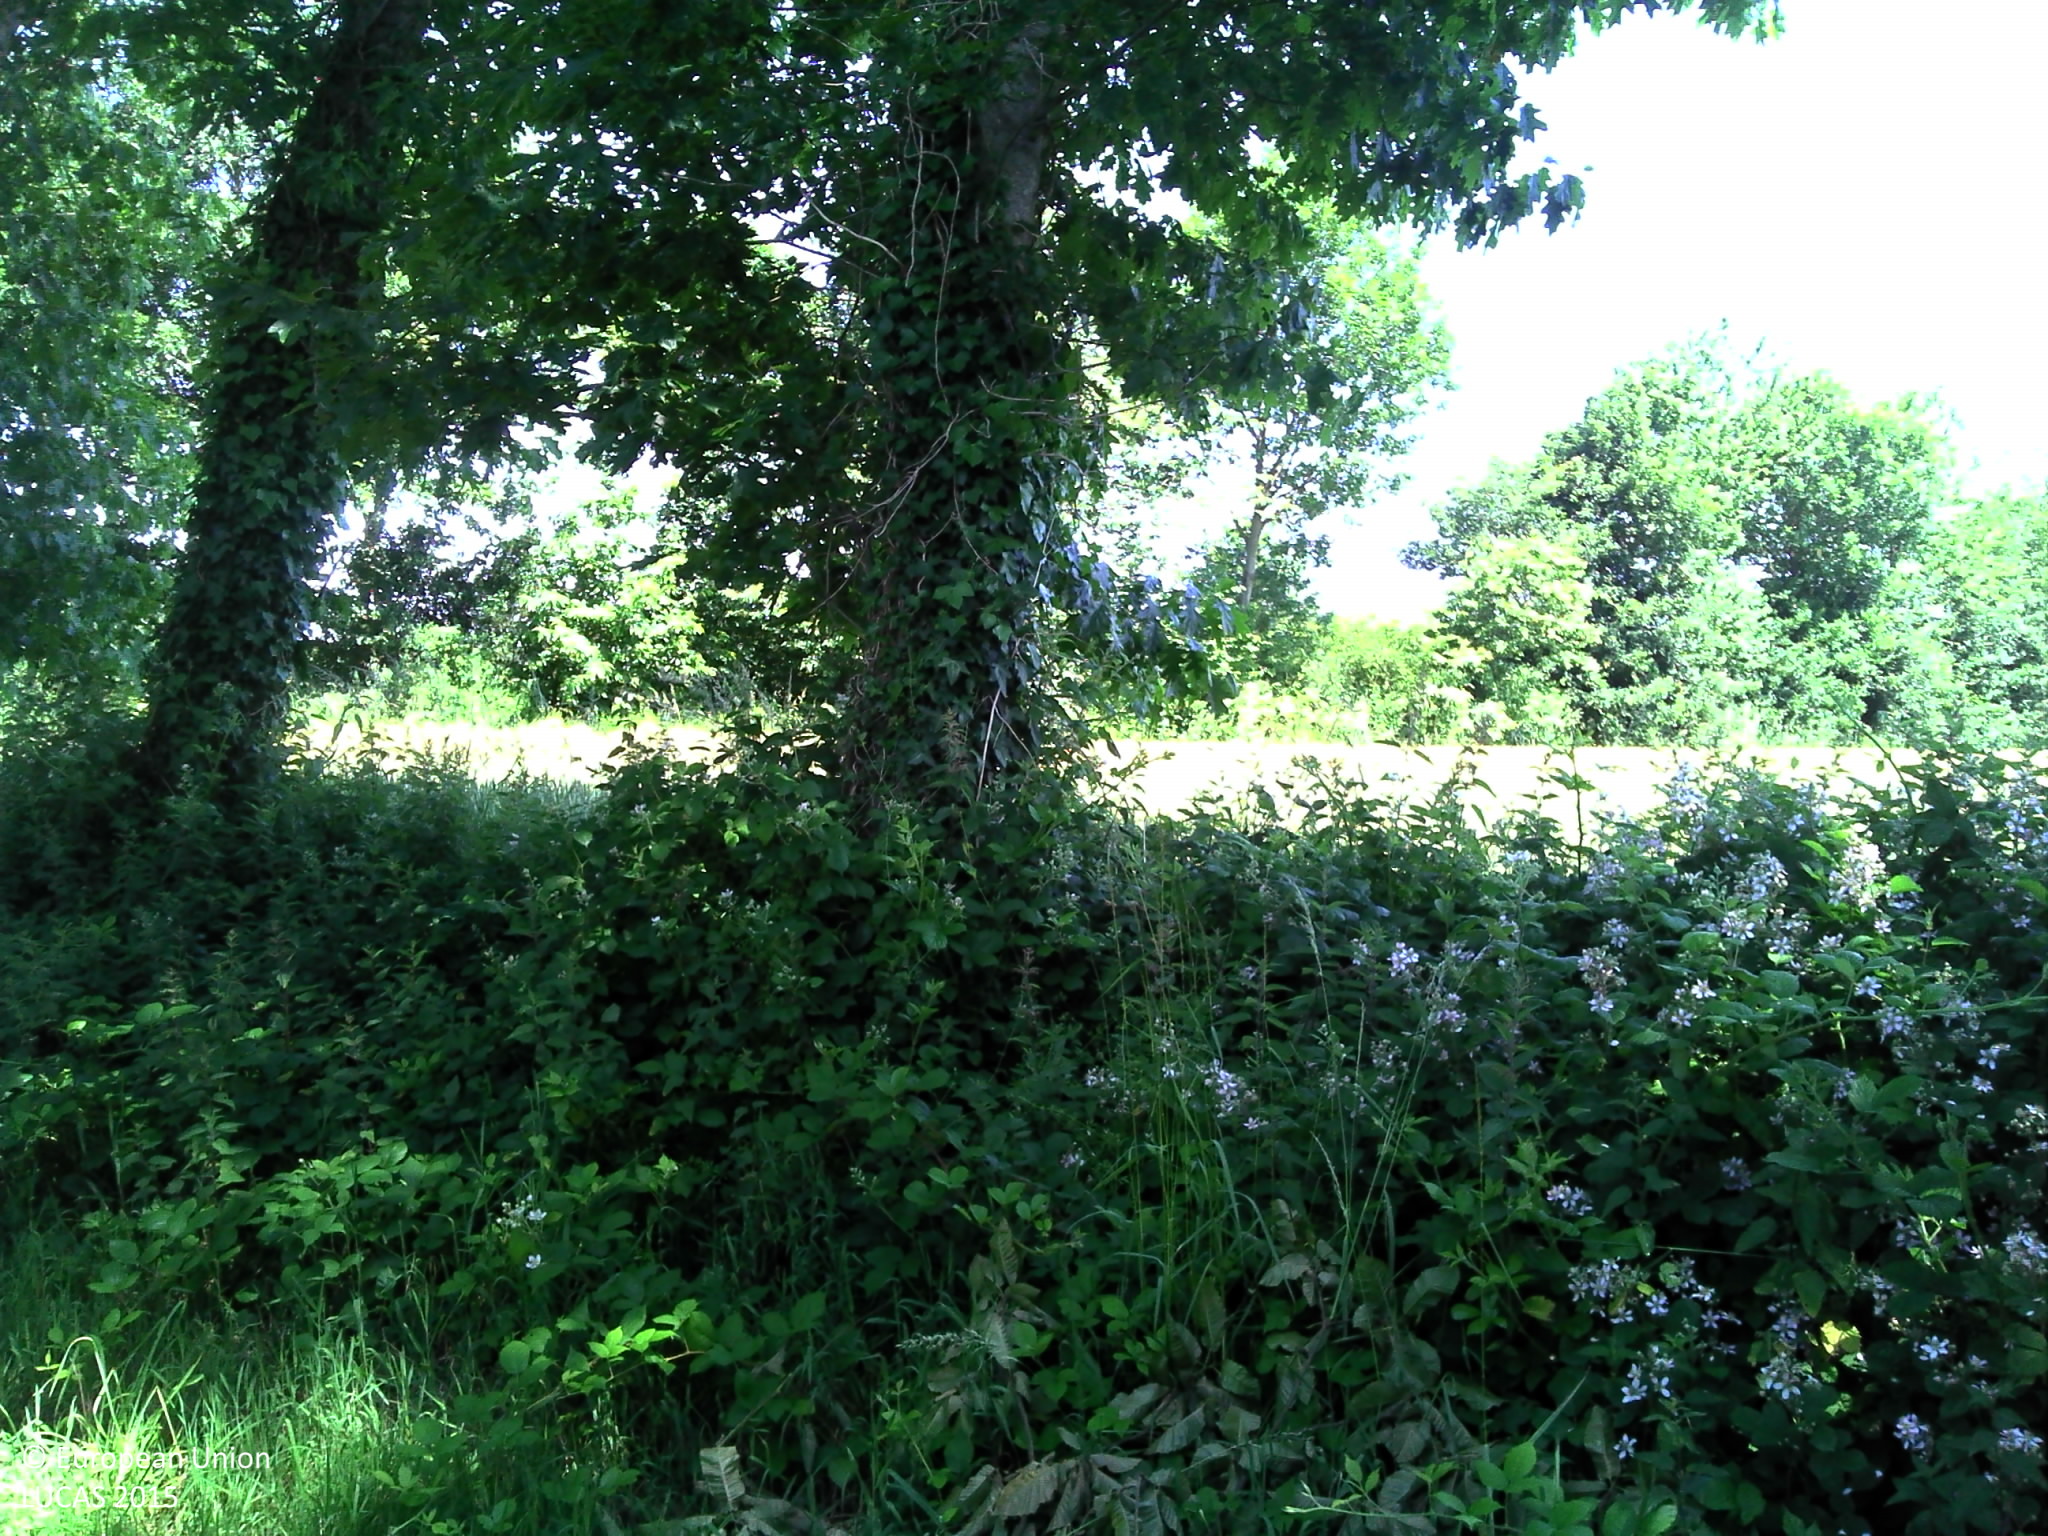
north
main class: Woodland
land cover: Broadleaved woodland
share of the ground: > 75 %
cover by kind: broadleaved forest trees 75 %, herbaceous plants 20 %, unconsolidated bare surface 5 %
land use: Forestry
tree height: > 5 m
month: June
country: FR
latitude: 48.3328
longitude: -1.7998
